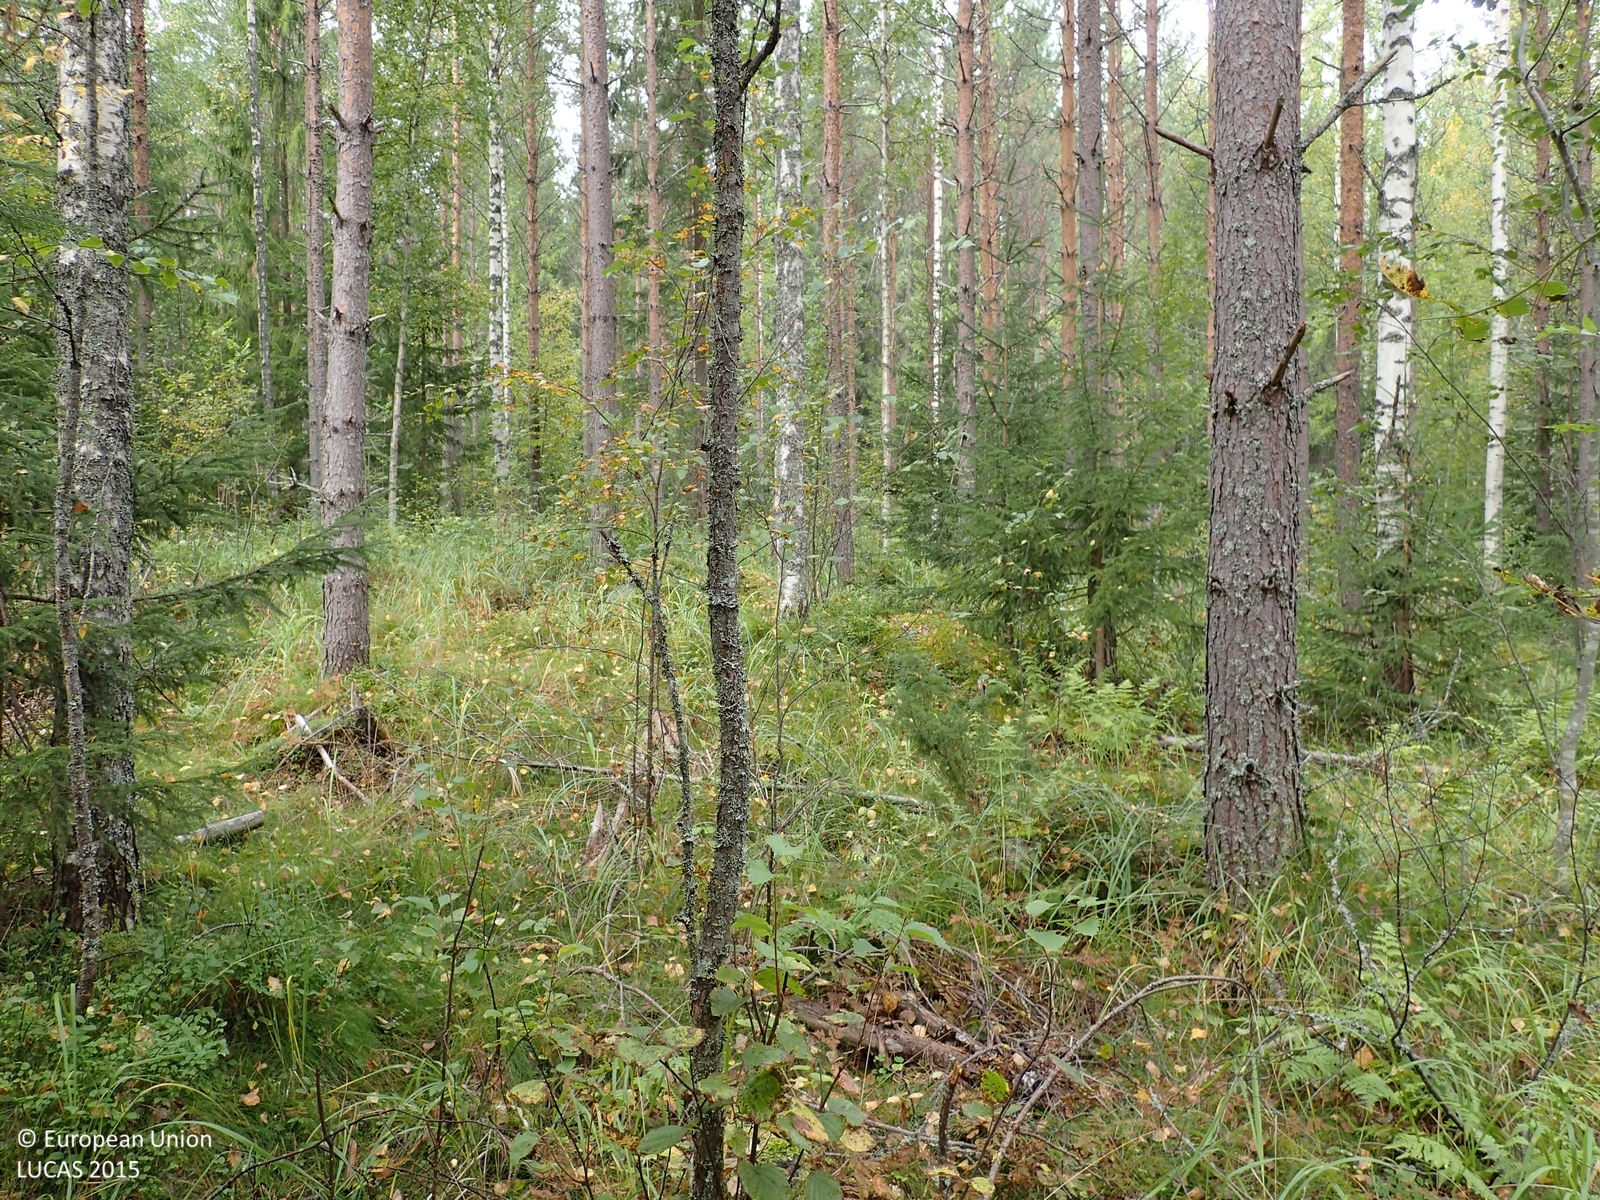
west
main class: Woodland
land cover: Pine dominated mixed woodland
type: boreal forest
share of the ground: > 75 %
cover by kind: coniferous forest trees 55 %, broadleaved forest trees 20 %, herbaceous plants 15 %, shrubs 5 %, lichens and mosses 5 %
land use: Forestry
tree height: > 5 m
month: September
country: FI
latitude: 62.9414
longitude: 25.9002
